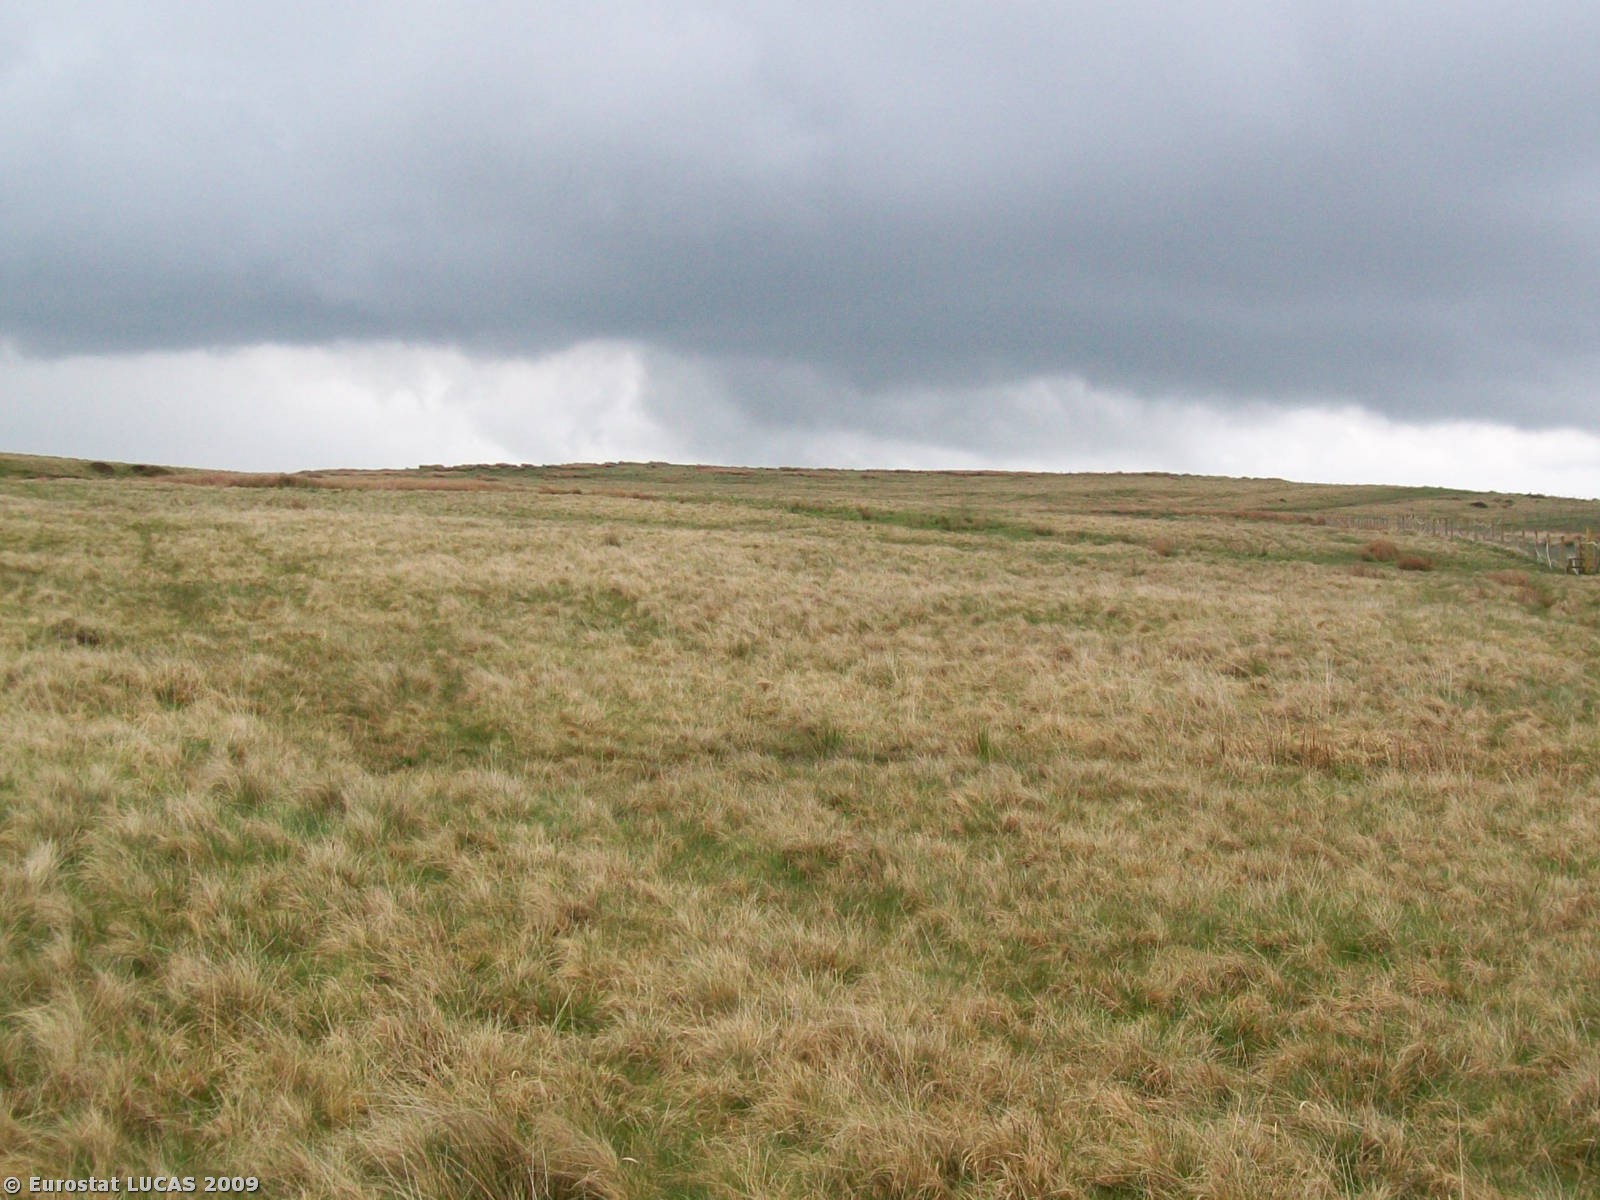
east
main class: Grassland
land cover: Grassland without tree/shrub cover
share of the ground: > 75 %
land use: Agriculture (excluding fallow land and kitchen gardens)
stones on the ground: < 10 %
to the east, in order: Grassland without tree/shrub cover; Tracks; Grassland without tree/shrub cover
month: May
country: GB
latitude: 51.9618
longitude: -3.6958
